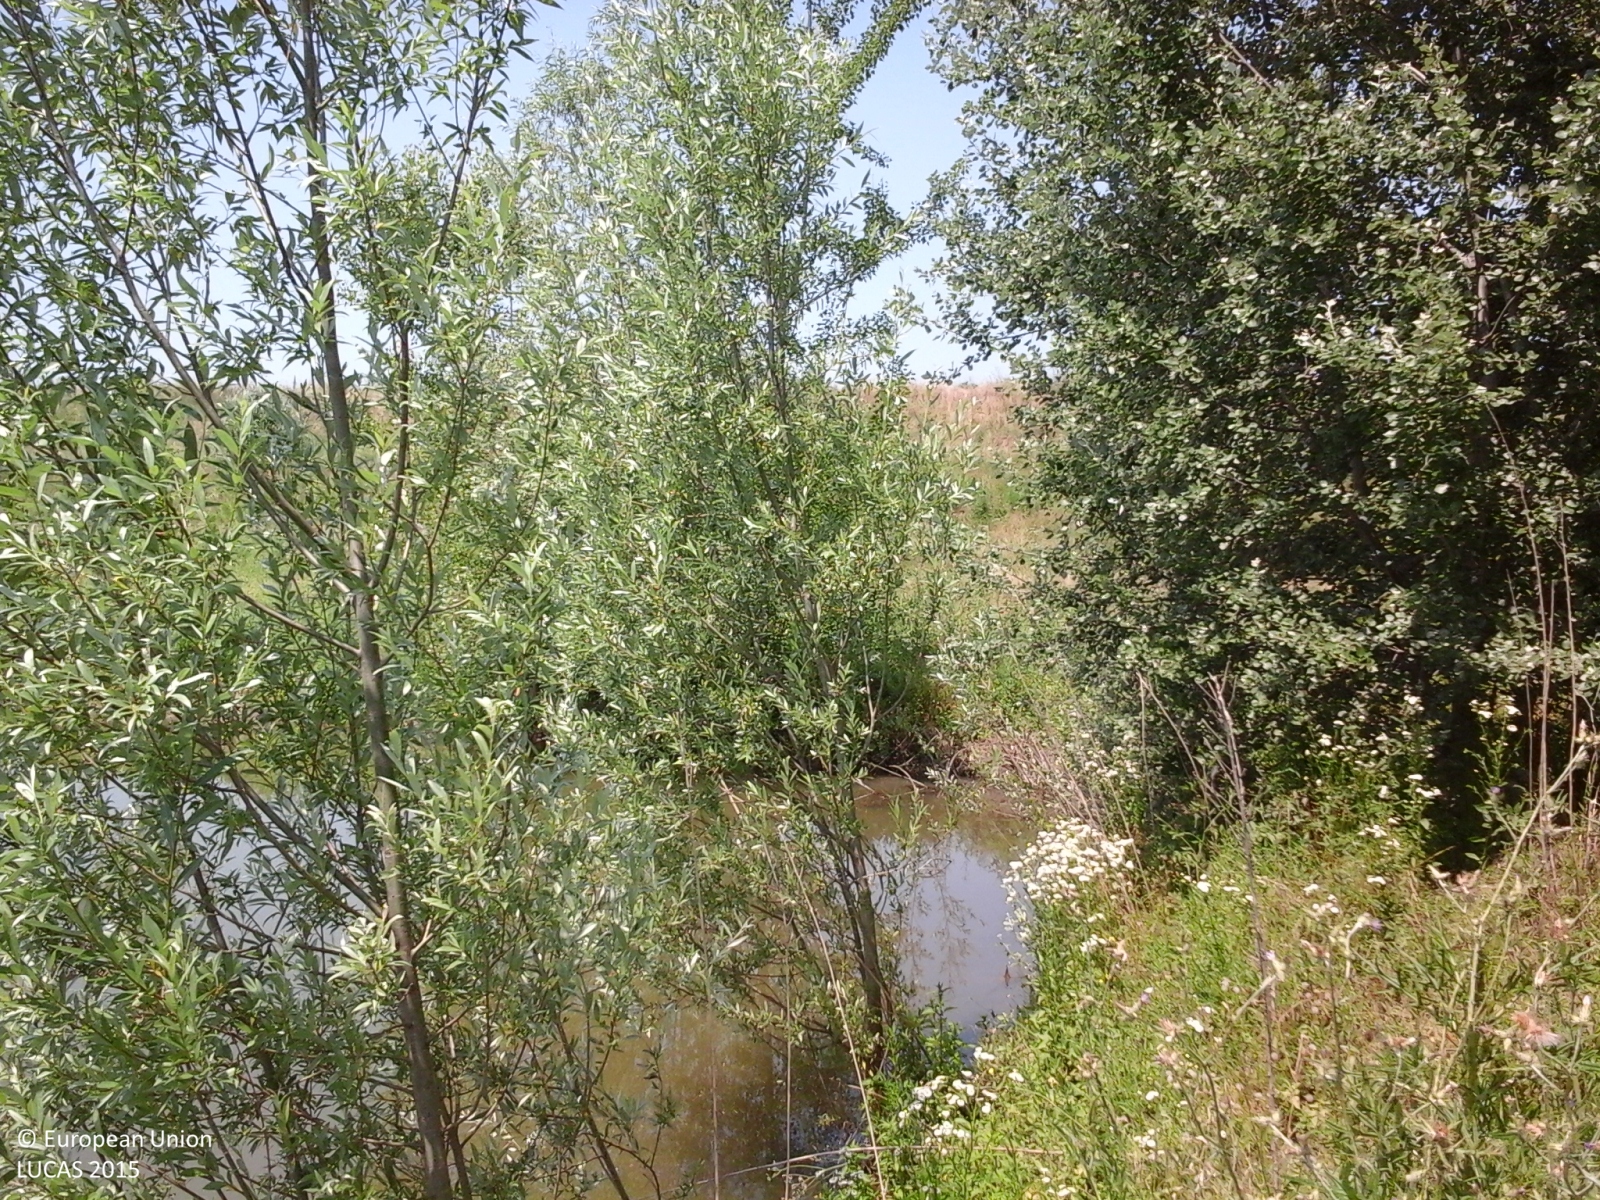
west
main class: Shrubland
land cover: Shrubland with sparse tree cover
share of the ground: > 75 %
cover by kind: shrubs 60 %, herbaceous plants 35 %, broadleaved forest trees 5 %
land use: Semi-natural and natural areas not in use
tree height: < 5 m
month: June
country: IT
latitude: 44.5962
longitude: 11.1942
